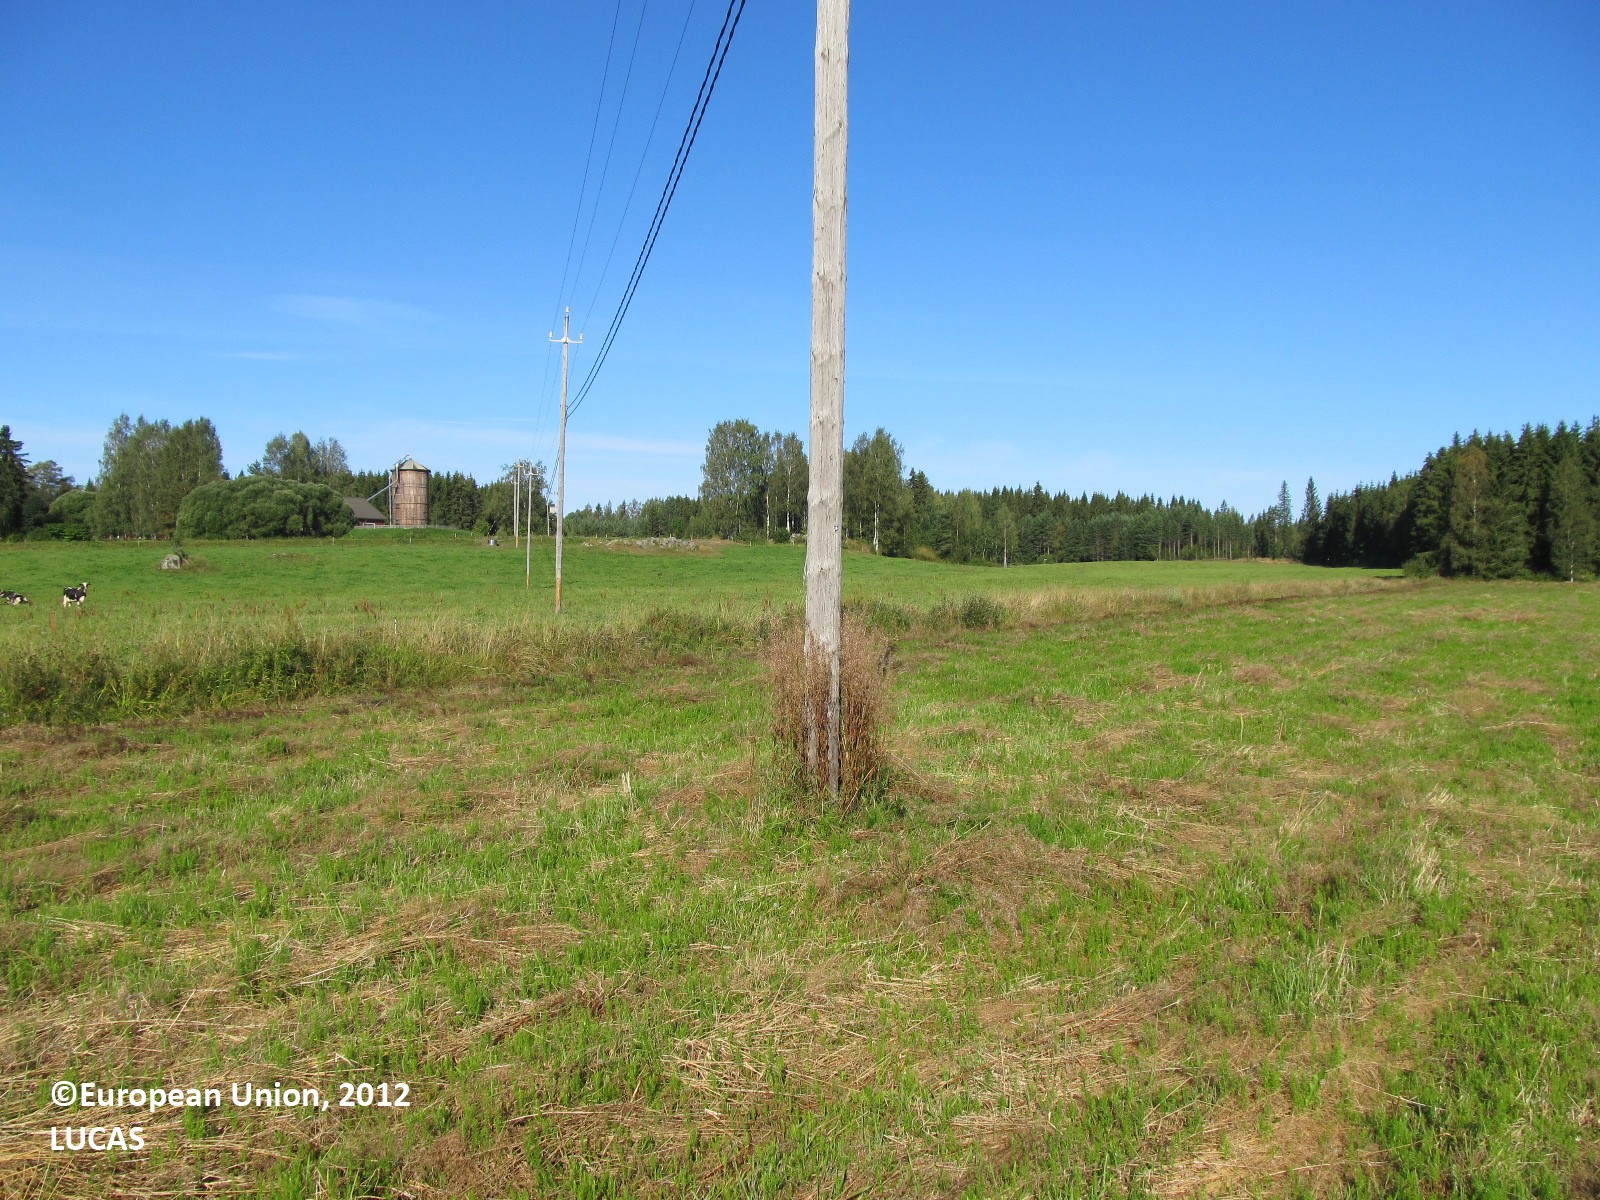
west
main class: Cropland
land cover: Temporary grasslands
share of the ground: 50 - 75 %
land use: Agriculture (excluding fallow land and kitchen gardens)
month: August
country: FI
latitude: 61.8325
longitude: 27.5122
